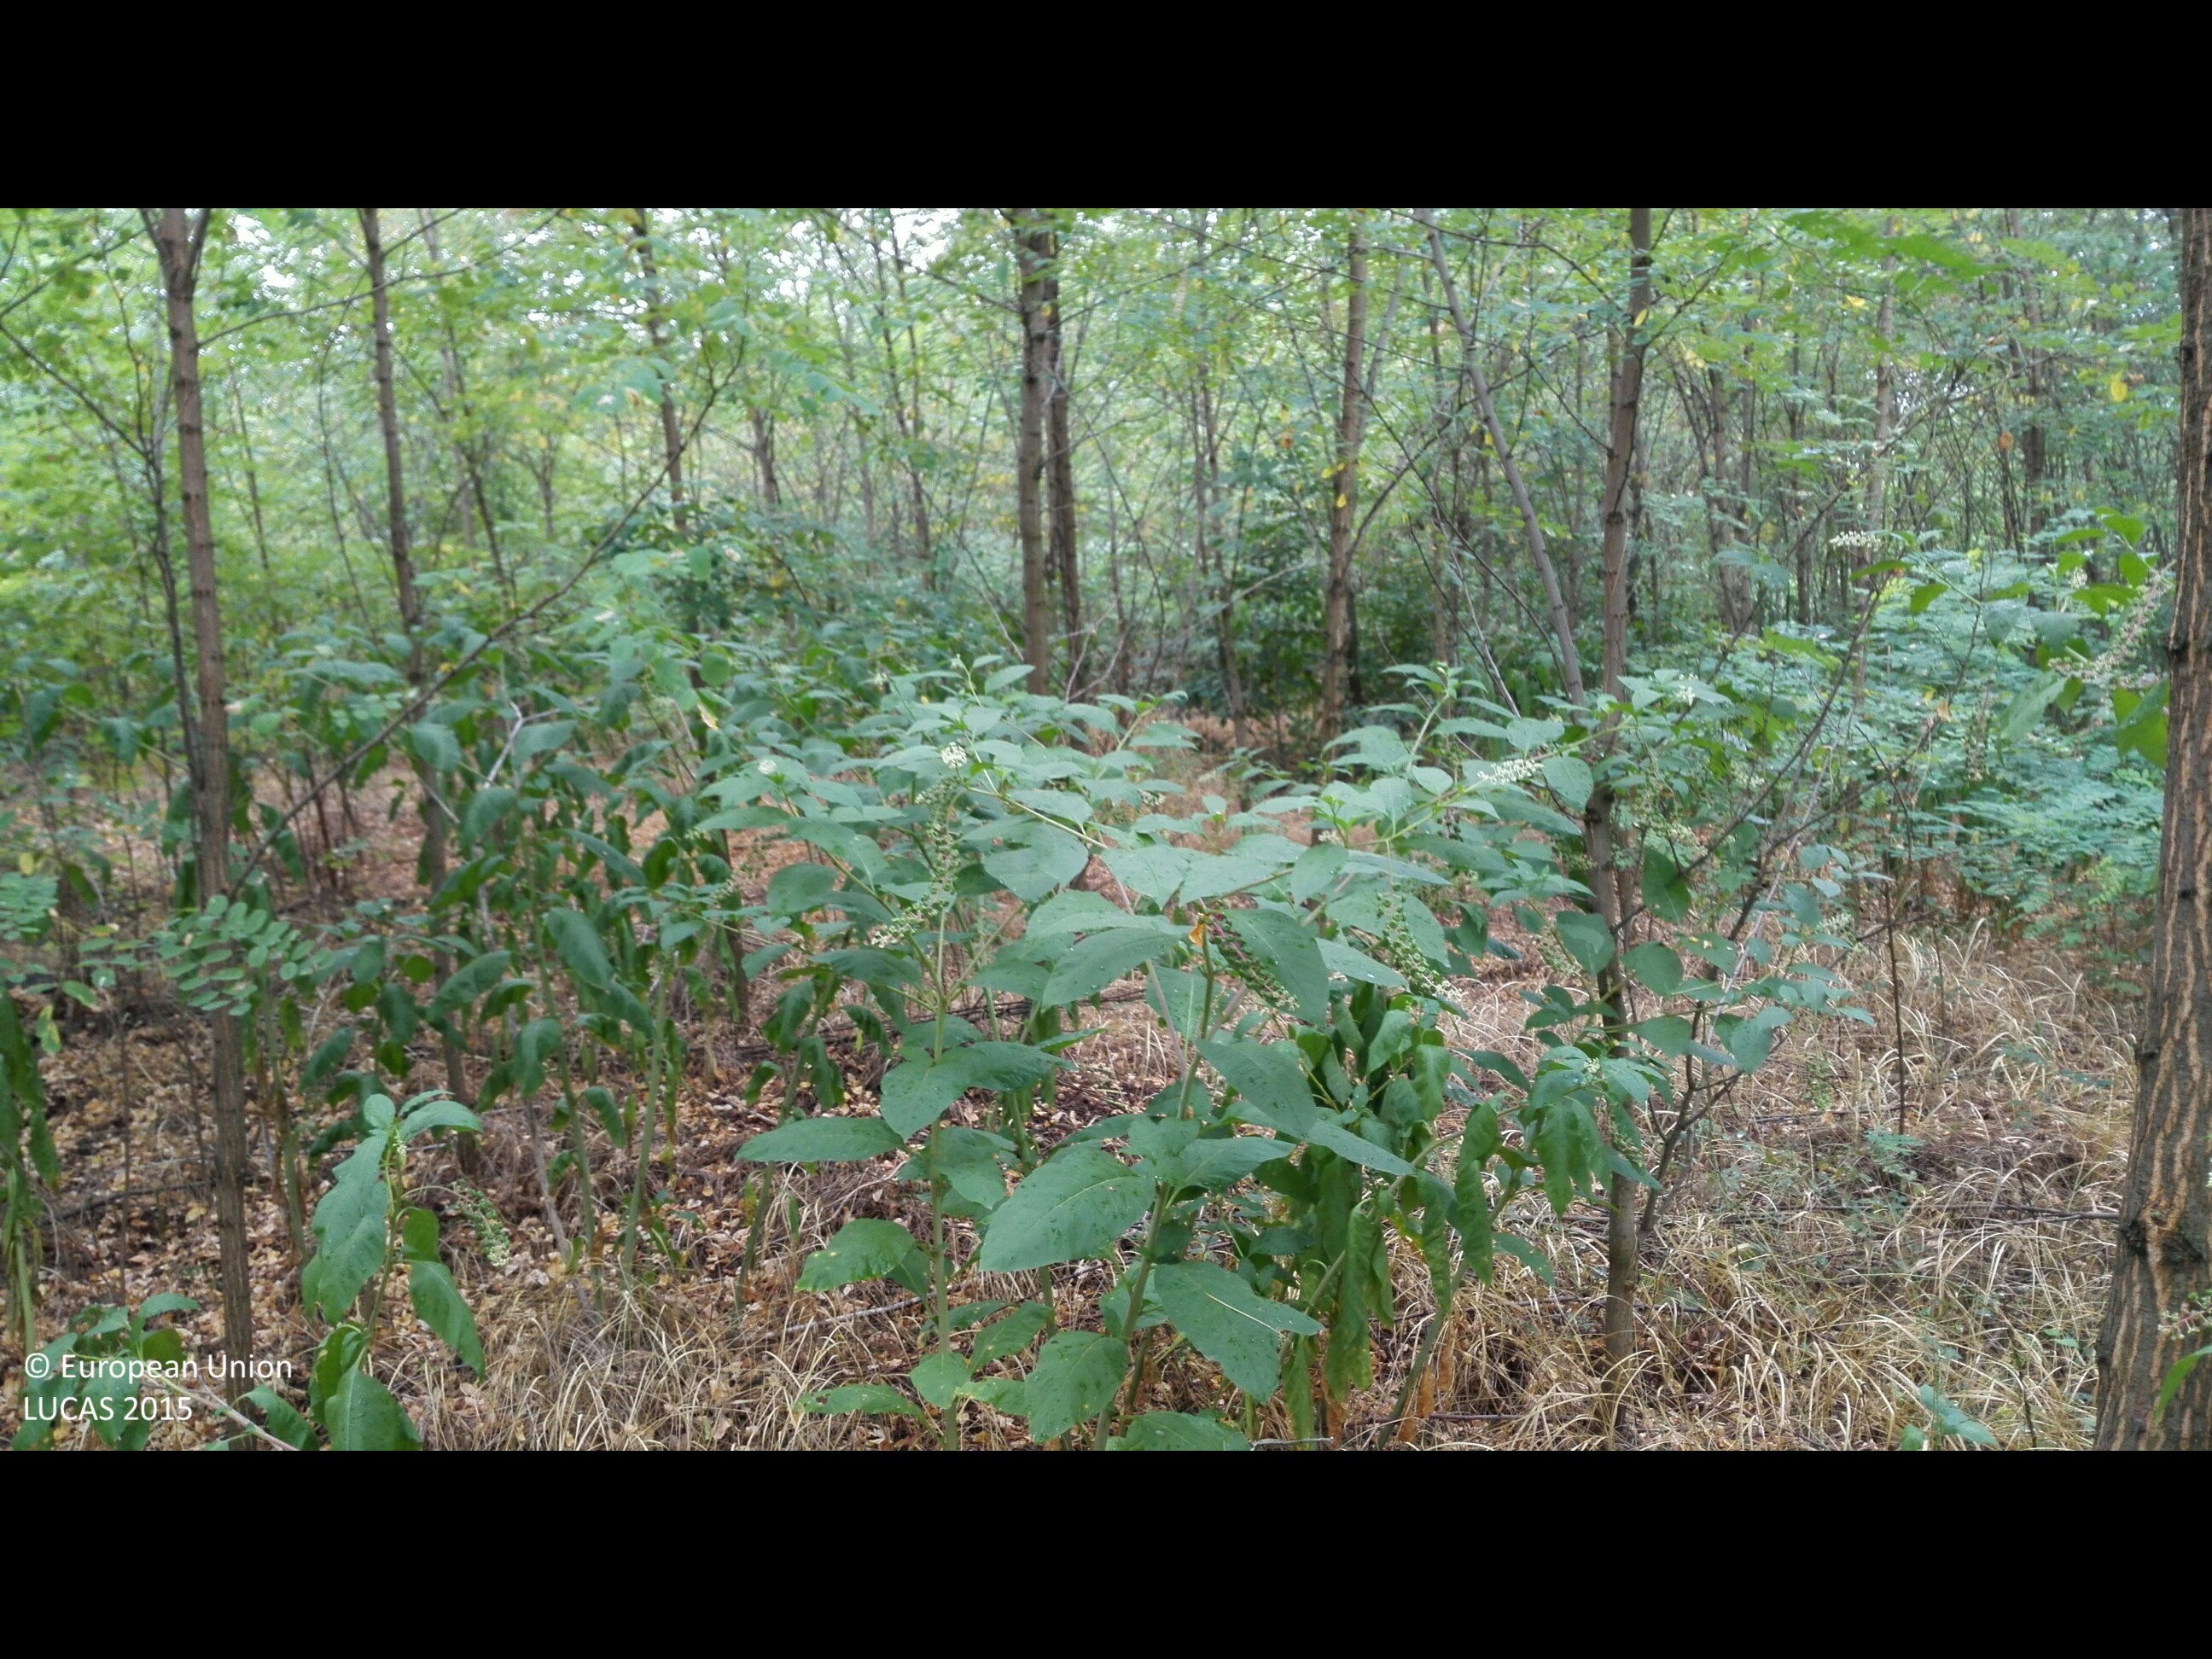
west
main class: Woodland
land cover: Broadleaved woodland
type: exotic forest
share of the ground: > 75 %
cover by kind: broadleaved forest trees 90 %, shrubs 5 %, herbaceous plants 5 %
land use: Forestry
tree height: > 5 m
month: August
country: HU
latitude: 47.7269
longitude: 21.6857
